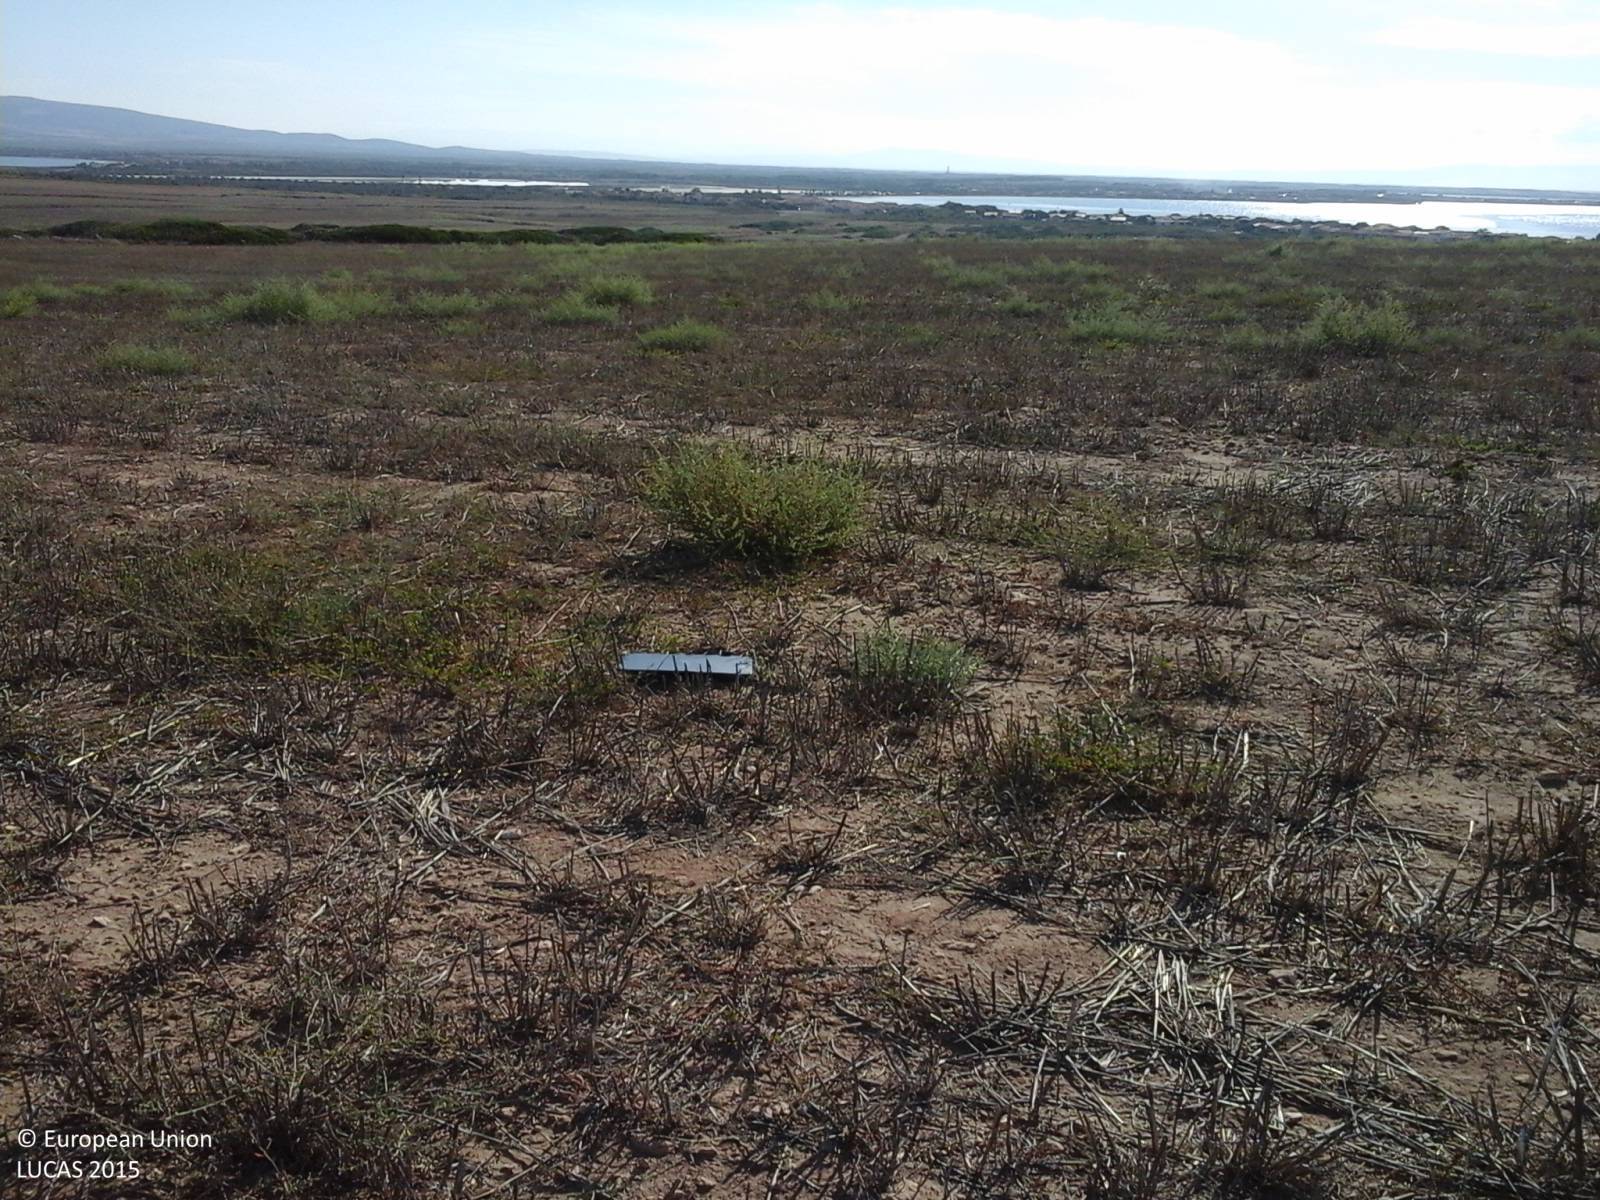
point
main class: Cropland
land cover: Mixed cereals for fodder
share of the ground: 10 - 25 %
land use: Agriculture (excluding fallow land and kitchen gardens)
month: September
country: IT
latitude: 40.0367
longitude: 8.3797
